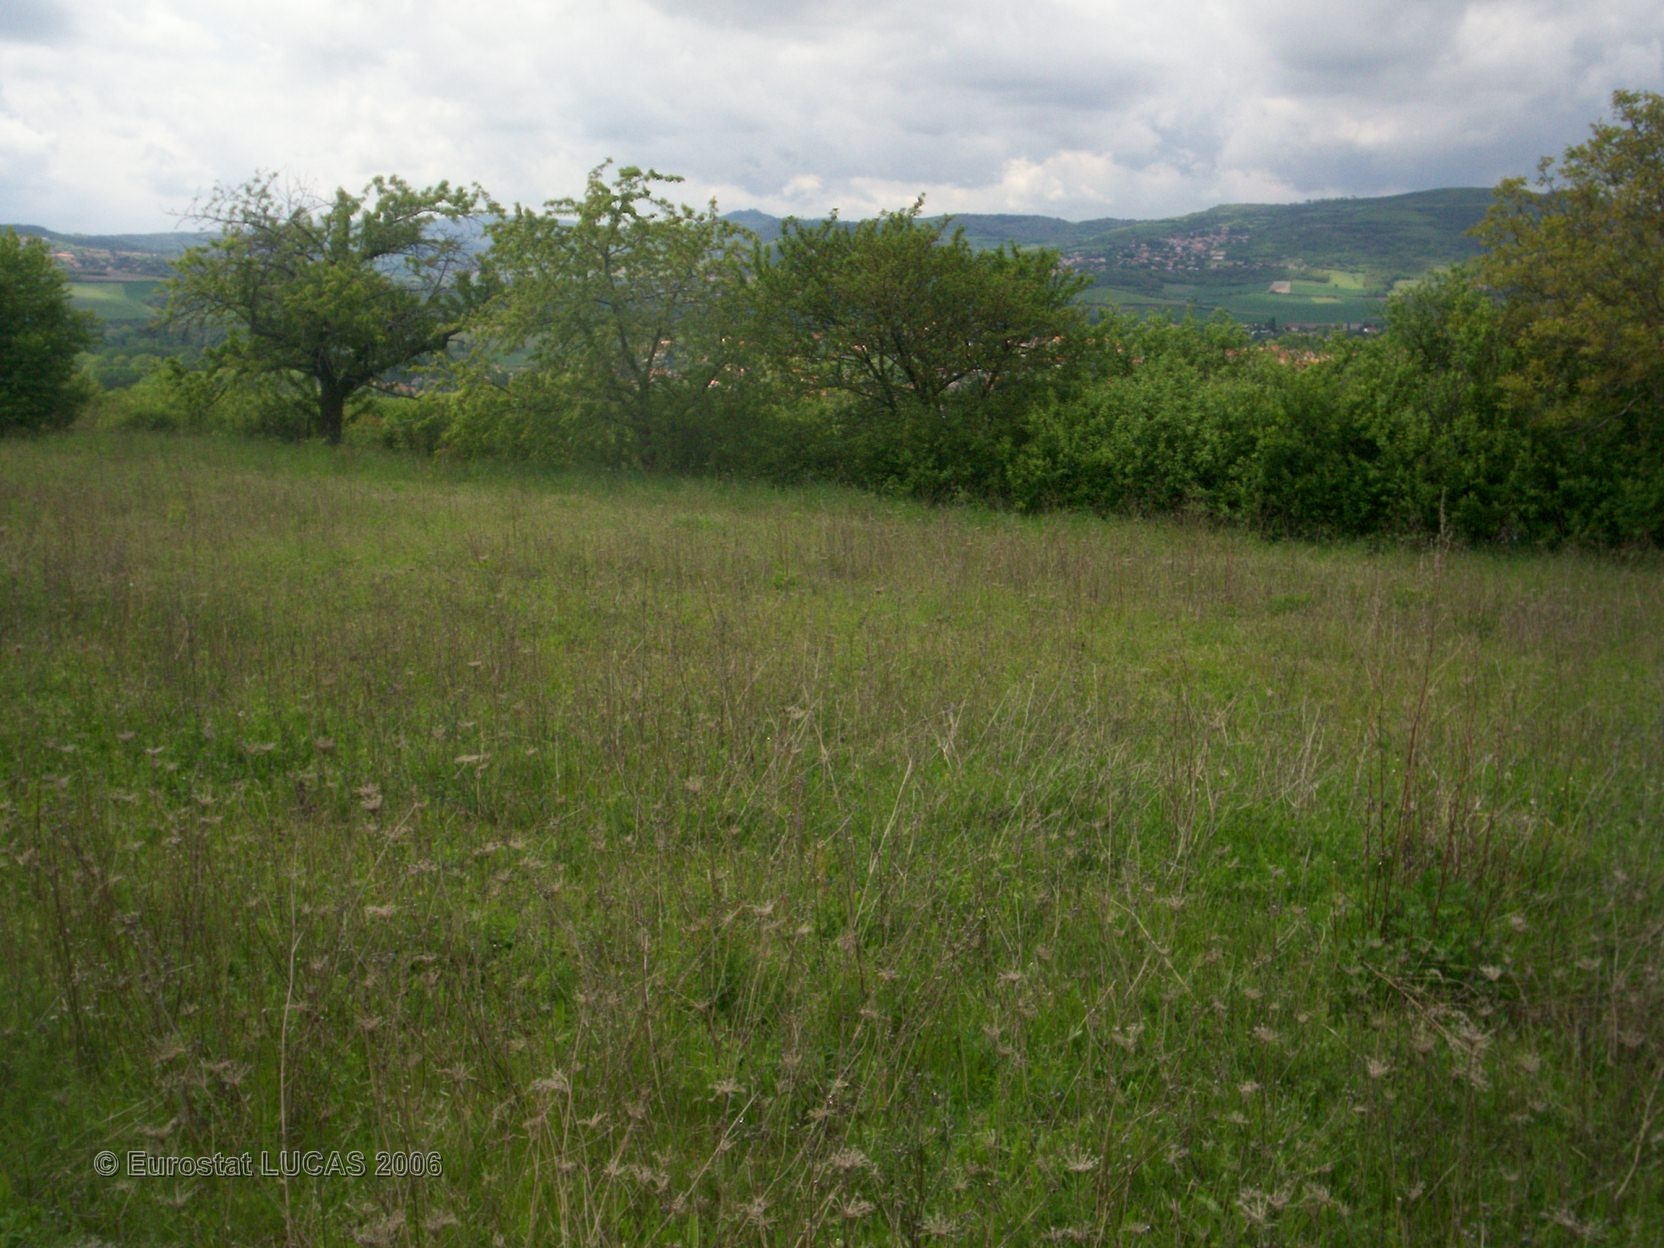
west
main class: Grassland
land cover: Grassland without tree/shrub cover
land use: Agriculture (excluding fallow land and kitchen gardens)
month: May
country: FR
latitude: 45.6996
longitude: 3.1806
